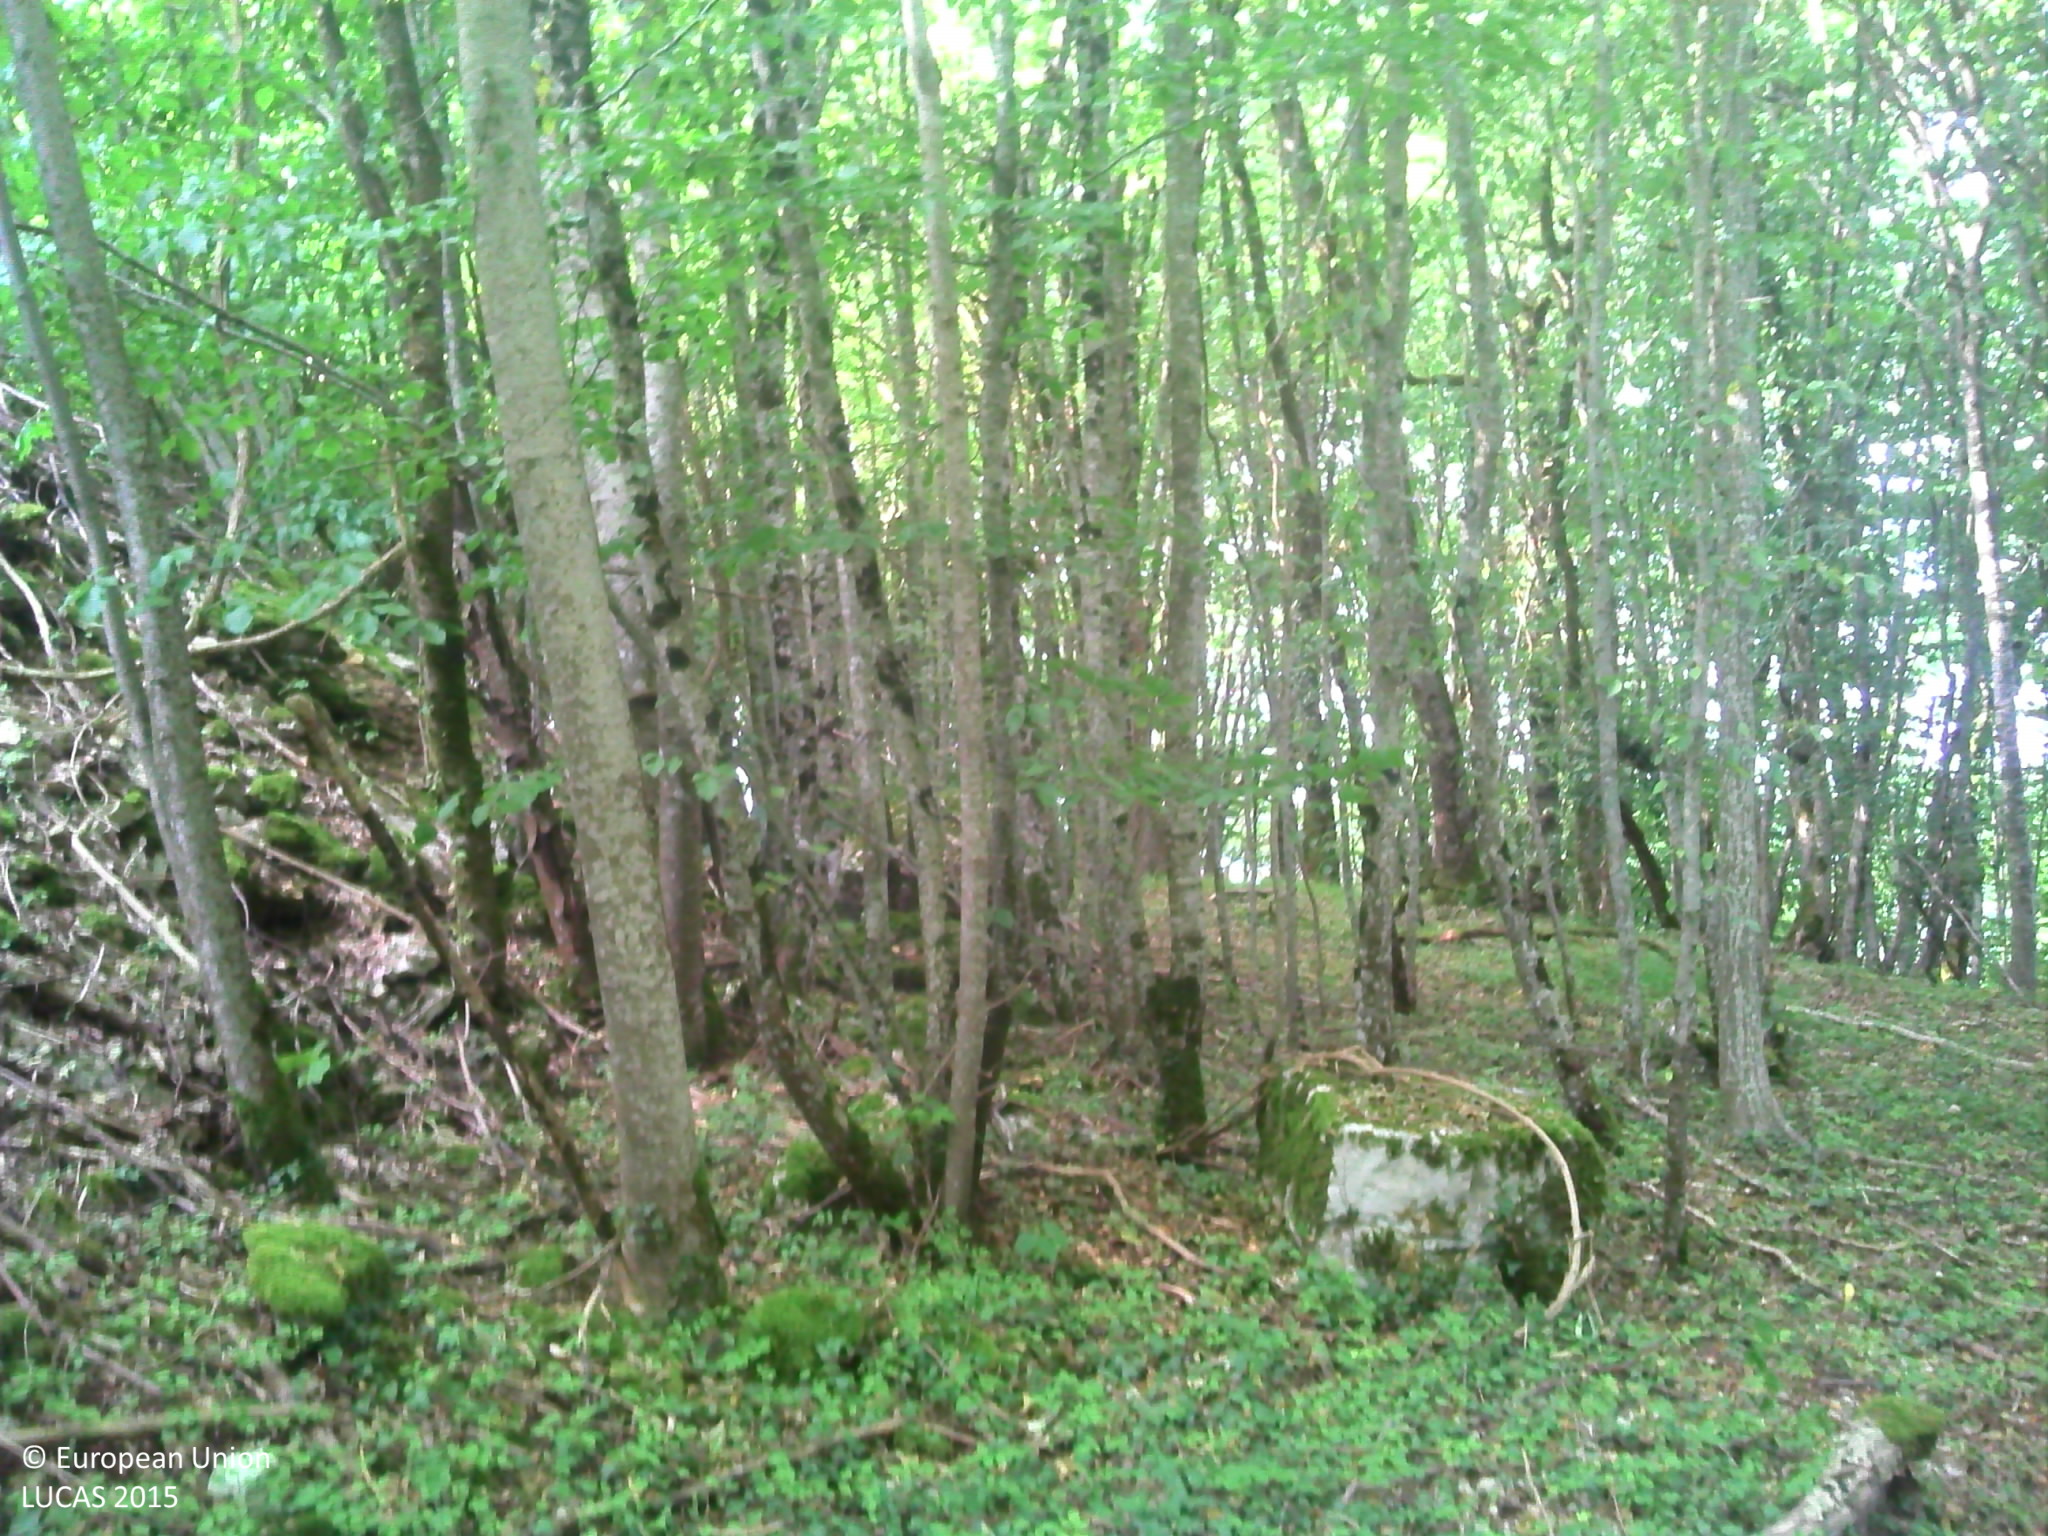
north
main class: Woodland
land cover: Broadleaved woodland
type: mesophytic deciduous forest
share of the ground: > 75 %
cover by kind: broadleaved forest trees 85 %, herbaceous plants 10 %, lichens and mosses 5 %
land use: Forestry
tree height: > 5 m
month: July
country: FR
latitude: 48.0810
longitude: 5.1534
